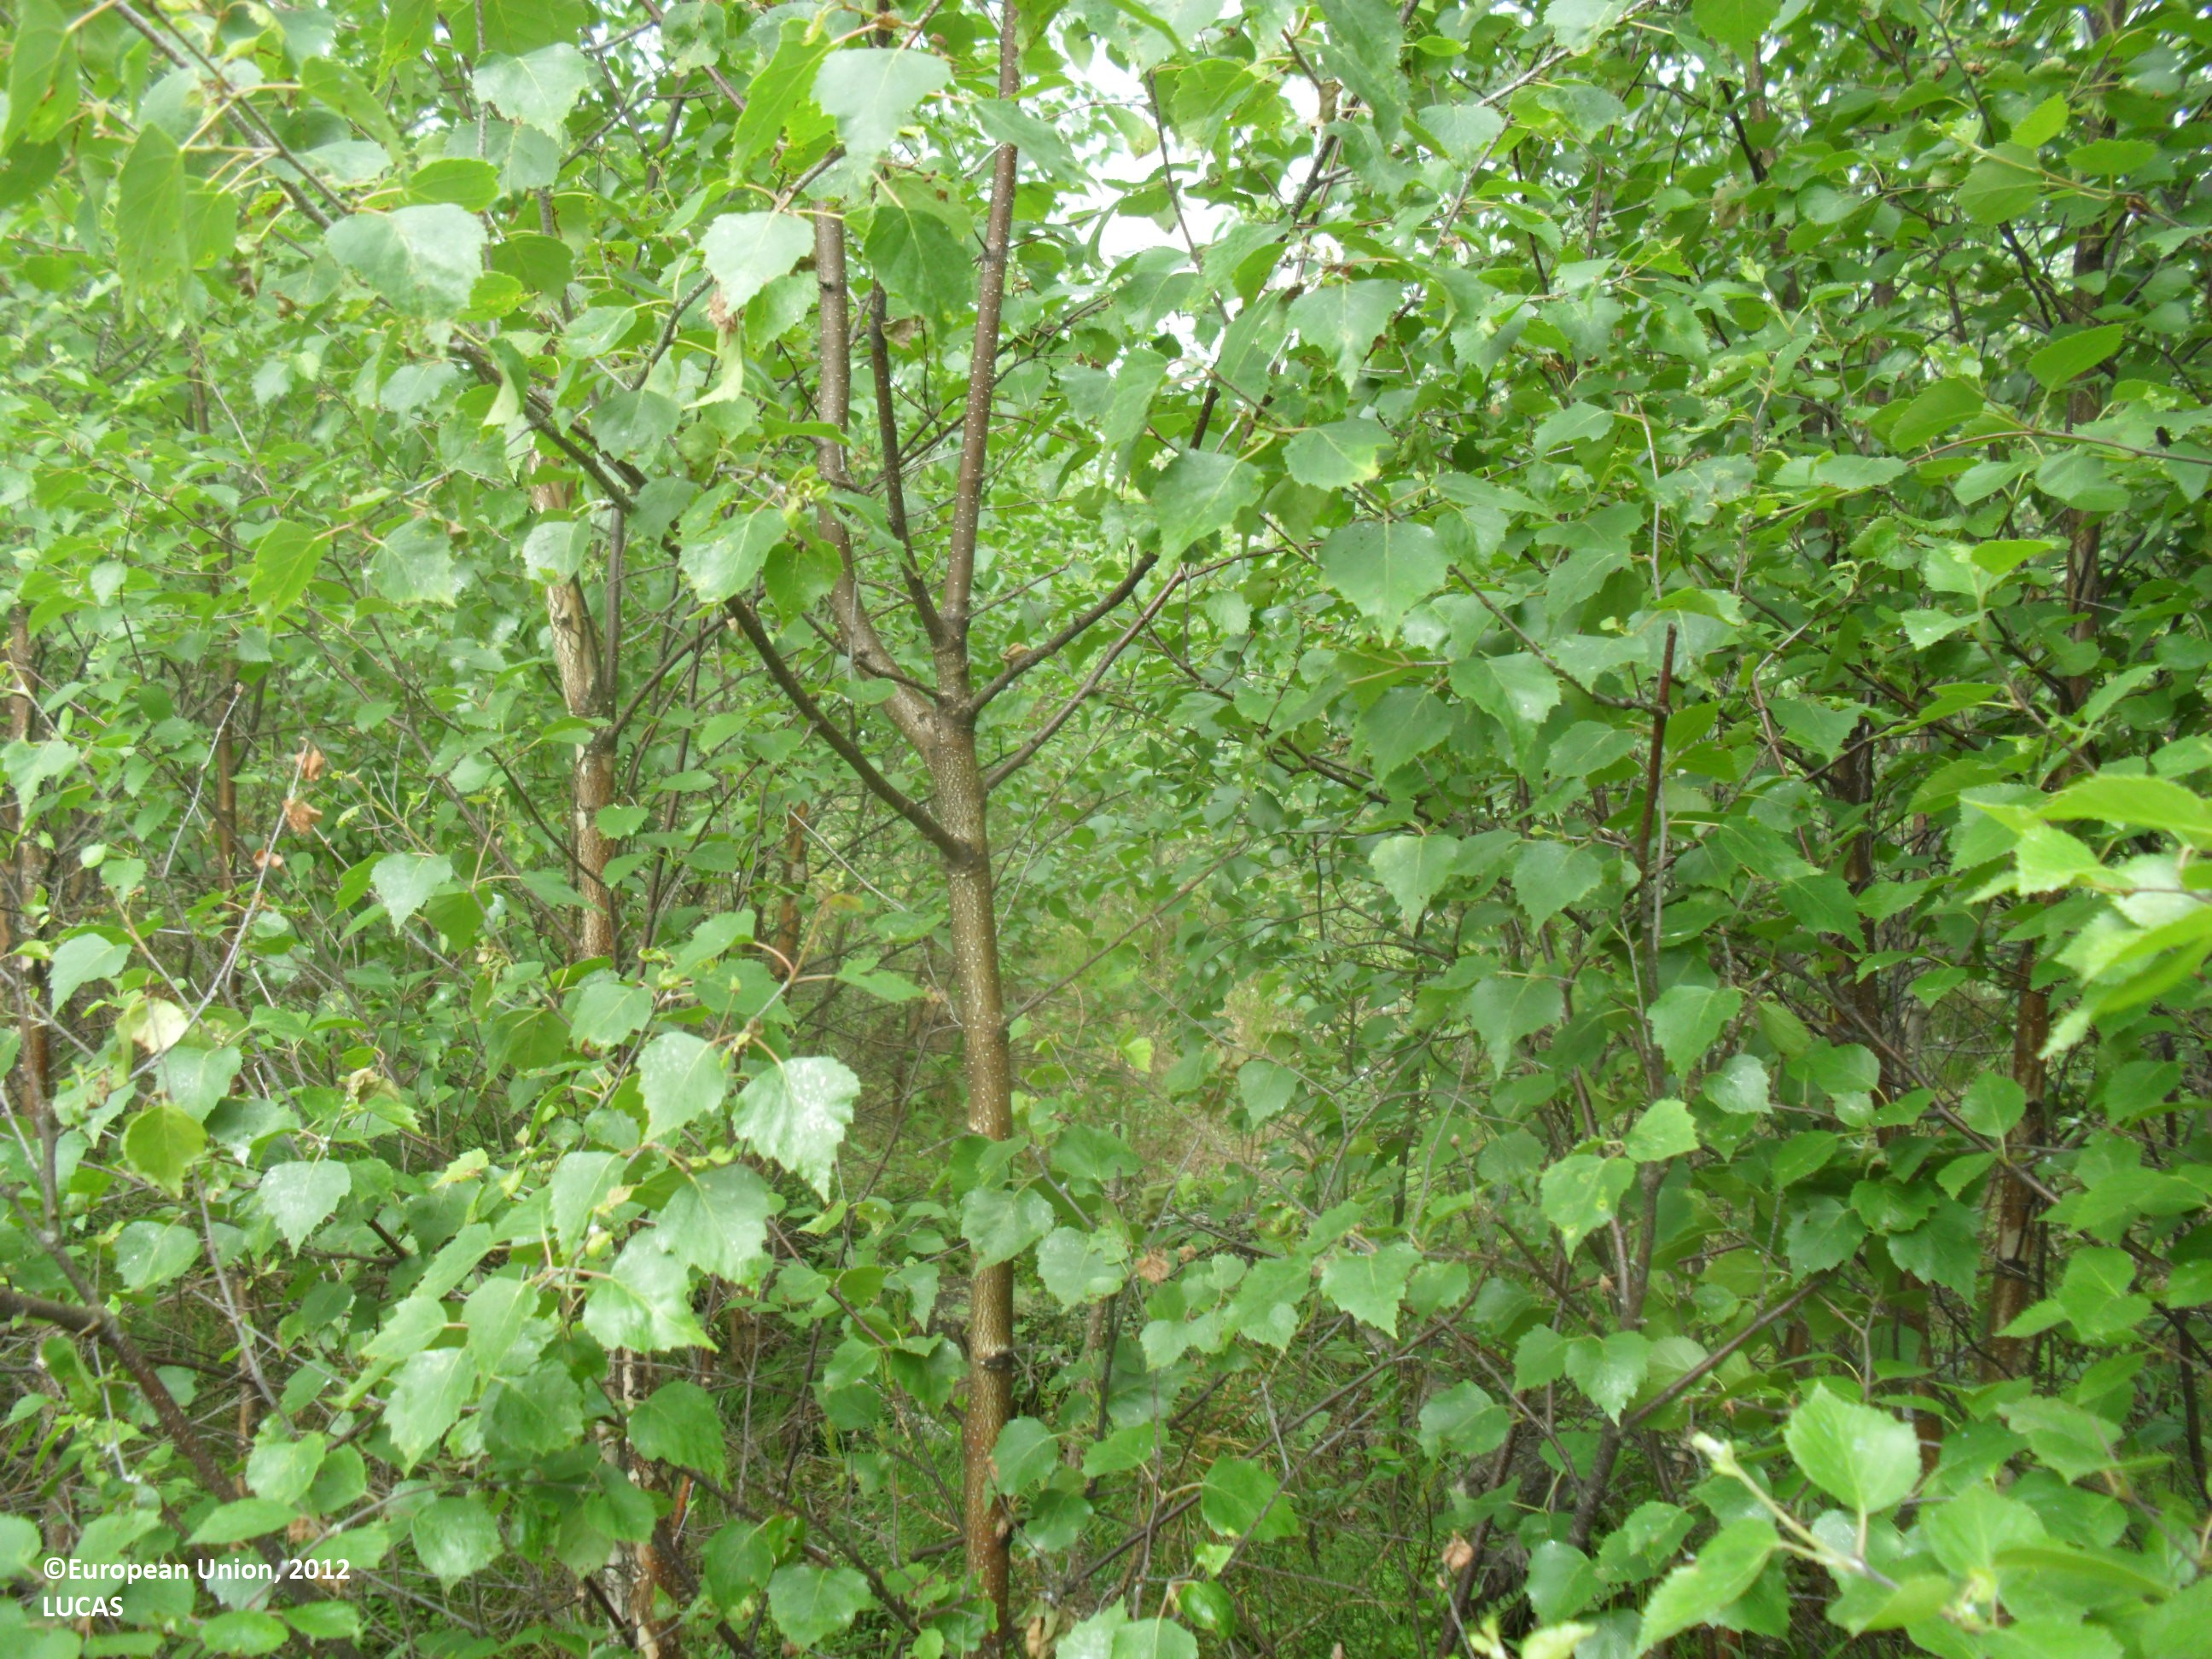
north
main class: Woodland
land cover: Other mixed woodland
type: boreal forest
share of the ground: 50 - 75 %
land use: Forestry
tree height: < 5 m
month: June
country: FI
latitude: 63.4594
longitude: 23.4002
